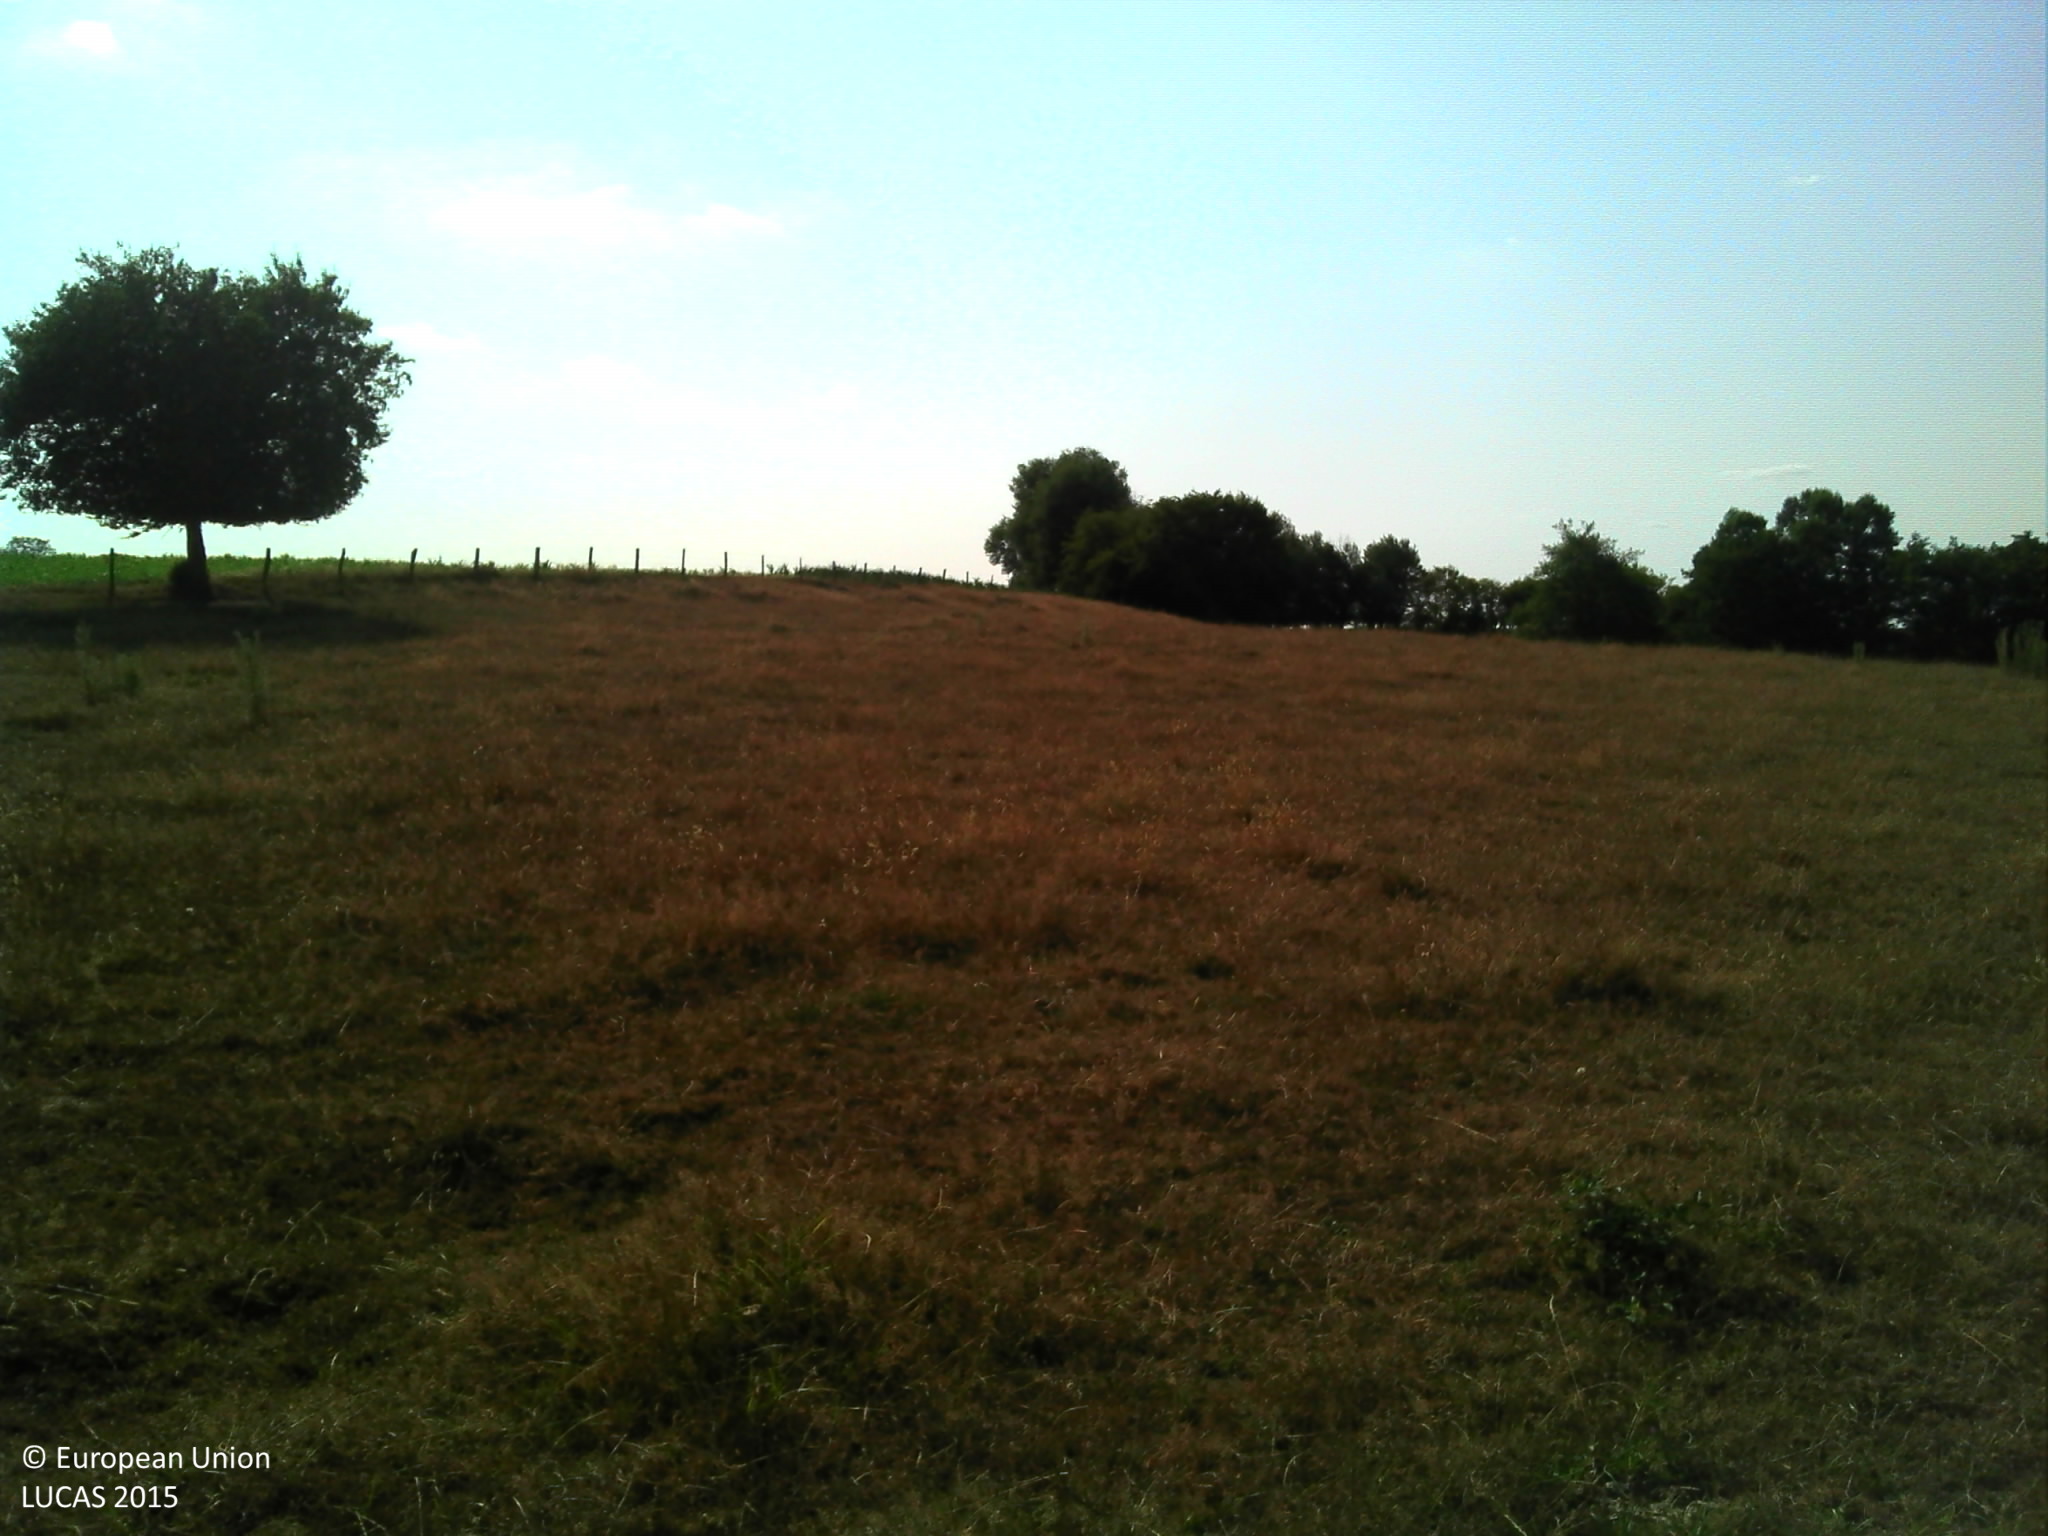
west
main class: Grassland
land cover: Grassland without tree/shrub cover
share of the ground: > 75 %
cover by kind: herbaceous plants 100 %
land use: Agriculture (excluding fallow land and kitchen gardens)
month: July
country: FR
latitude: 46.8123
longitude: 3.6423
